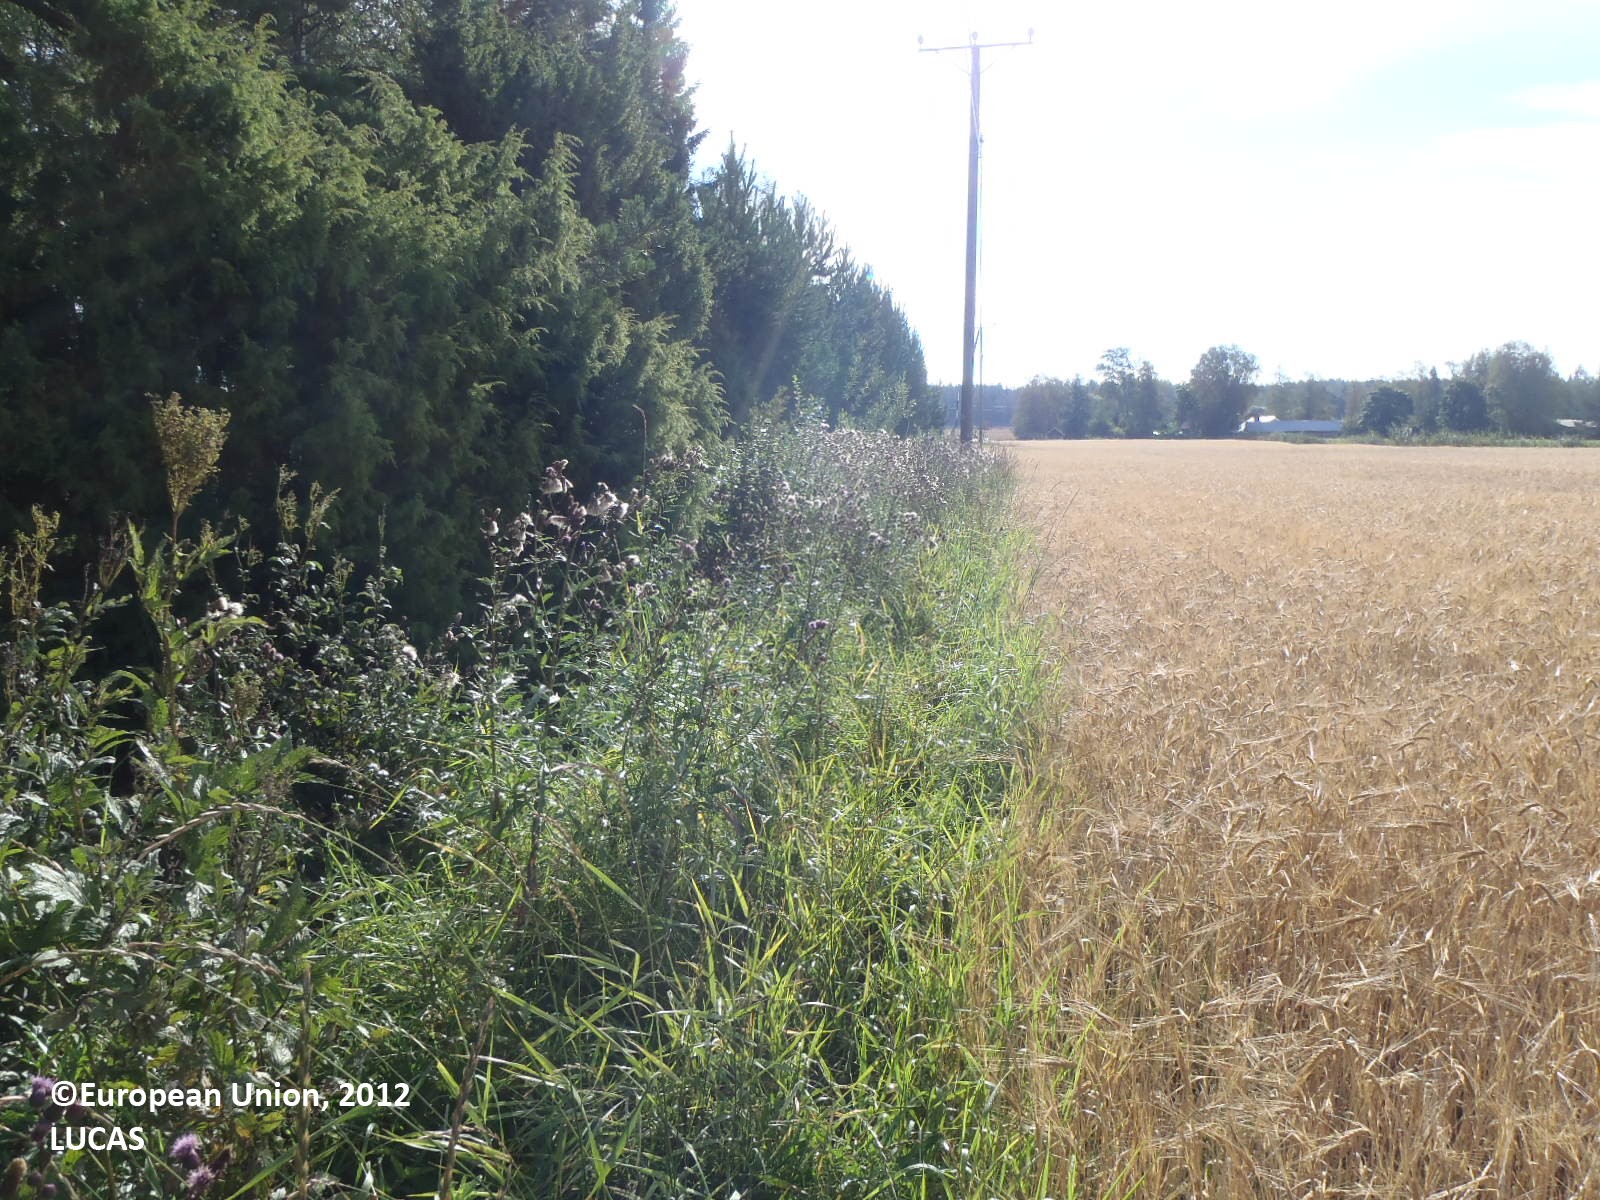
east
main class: Cropland
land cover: Barley
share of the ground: > 75 %
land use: Agriculture (excluding fallow land and kitchen gardens)
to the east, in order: Barley; Electric lines; Grass margins; Ditches and canals; Grass margins; Paved roads, cycling and walking lanes; Grass margins; Ditches and canals; Grass margins; Barley; Potatoes
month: August
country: FI
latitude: 60.6262
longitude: 22.2934
